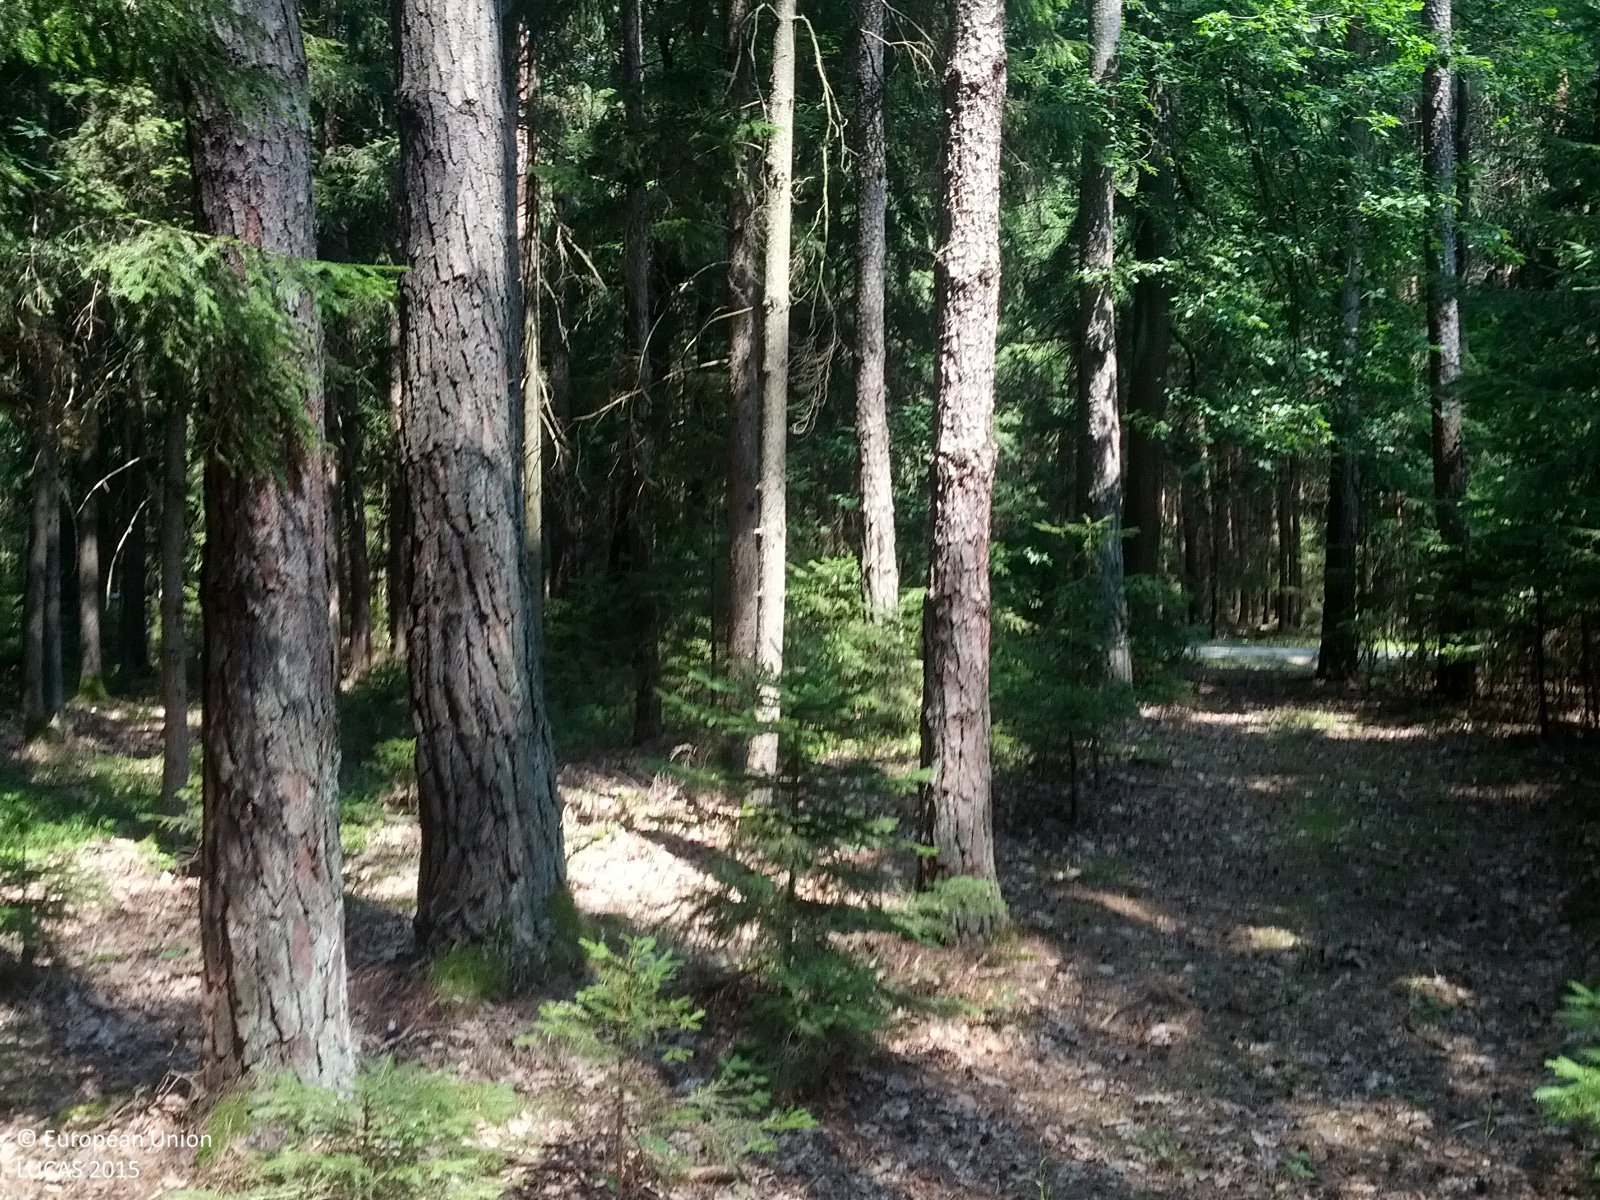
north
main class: Woodland
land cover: Pine dominated coniferous woodland
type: hemiboreal forest and nemoral coniferous forest and mixed broadleaved-coniferous forest
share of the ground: > 75 %
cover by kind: coniferous forest trees 90 %, broadleaved forest trees 5 %, herbaceous plants 5 %
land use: Forestry
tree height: > 5 m
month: July
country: AT
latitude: 47.2235
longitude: 16.1164
